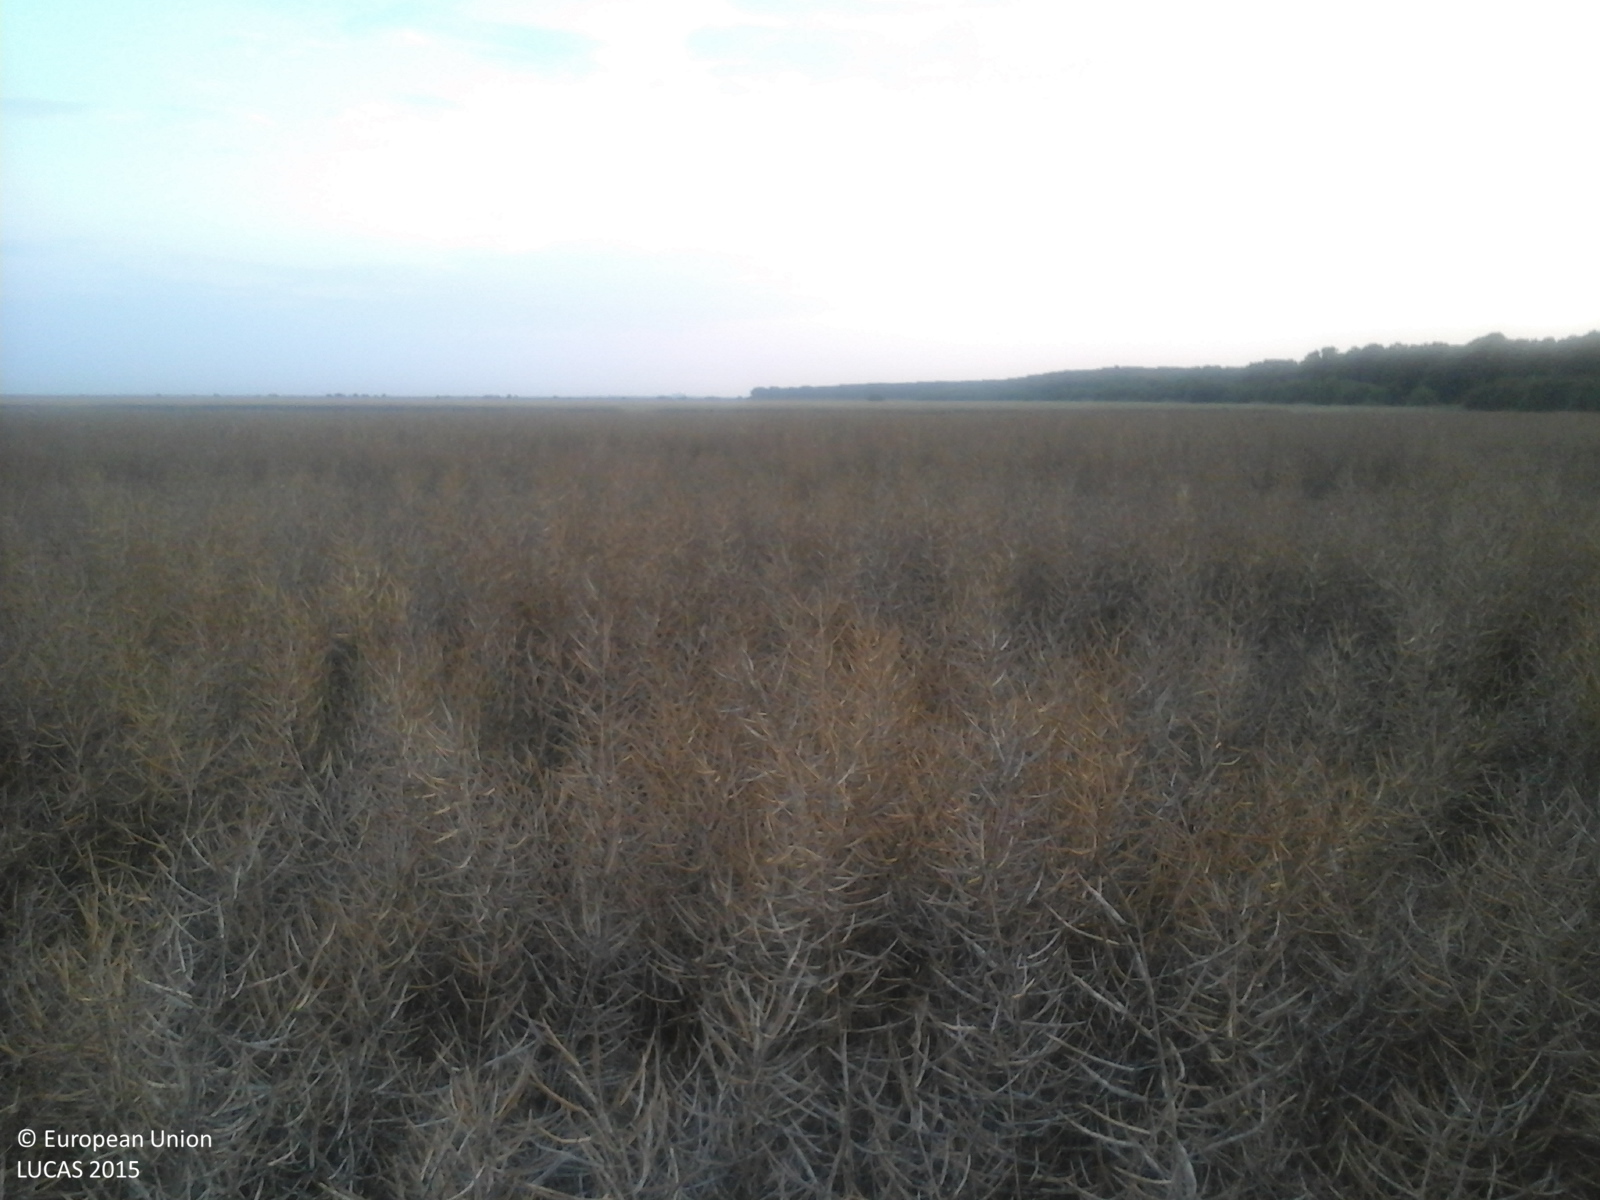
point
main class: Cropland
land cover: Rape and turnip rape
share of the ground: > 75 %
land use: Agriculture (excluding fallow land and kitchen gardens)
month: July
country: RO
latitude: 44.0359
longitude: 25.8809
